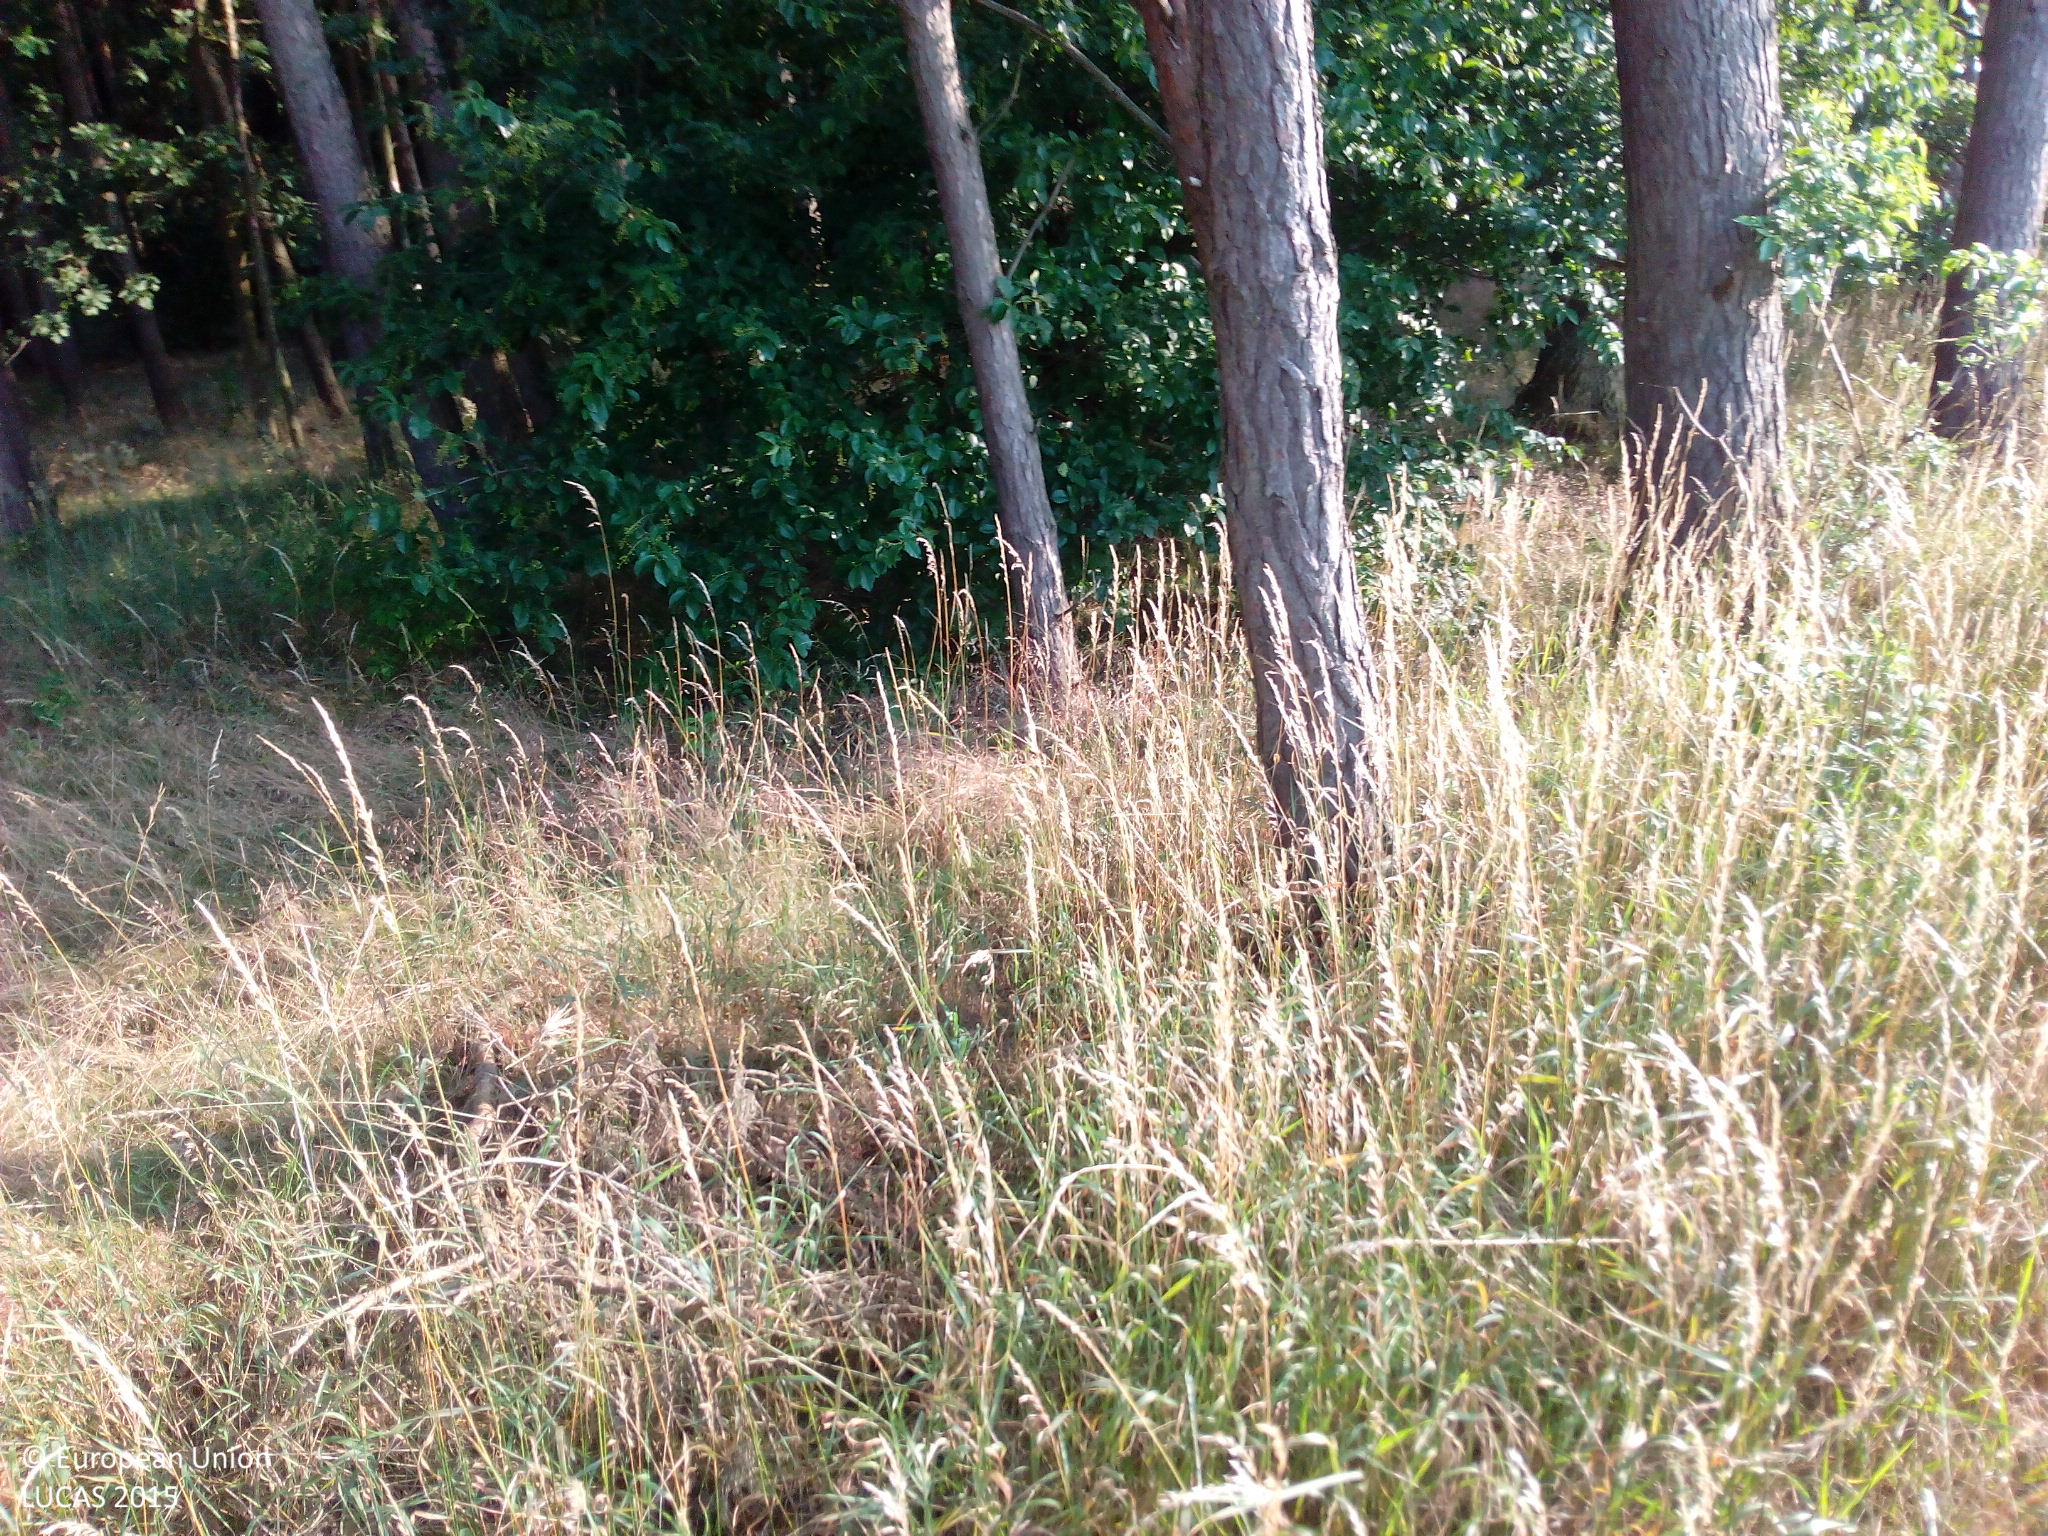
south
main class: Cropland
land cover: Rape and turnip rape
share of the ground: > 75 %
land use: Agriculture (excluding fallow land and kitchen gardens)
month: July
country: DE
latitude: 52.7318
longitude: 12.3541
